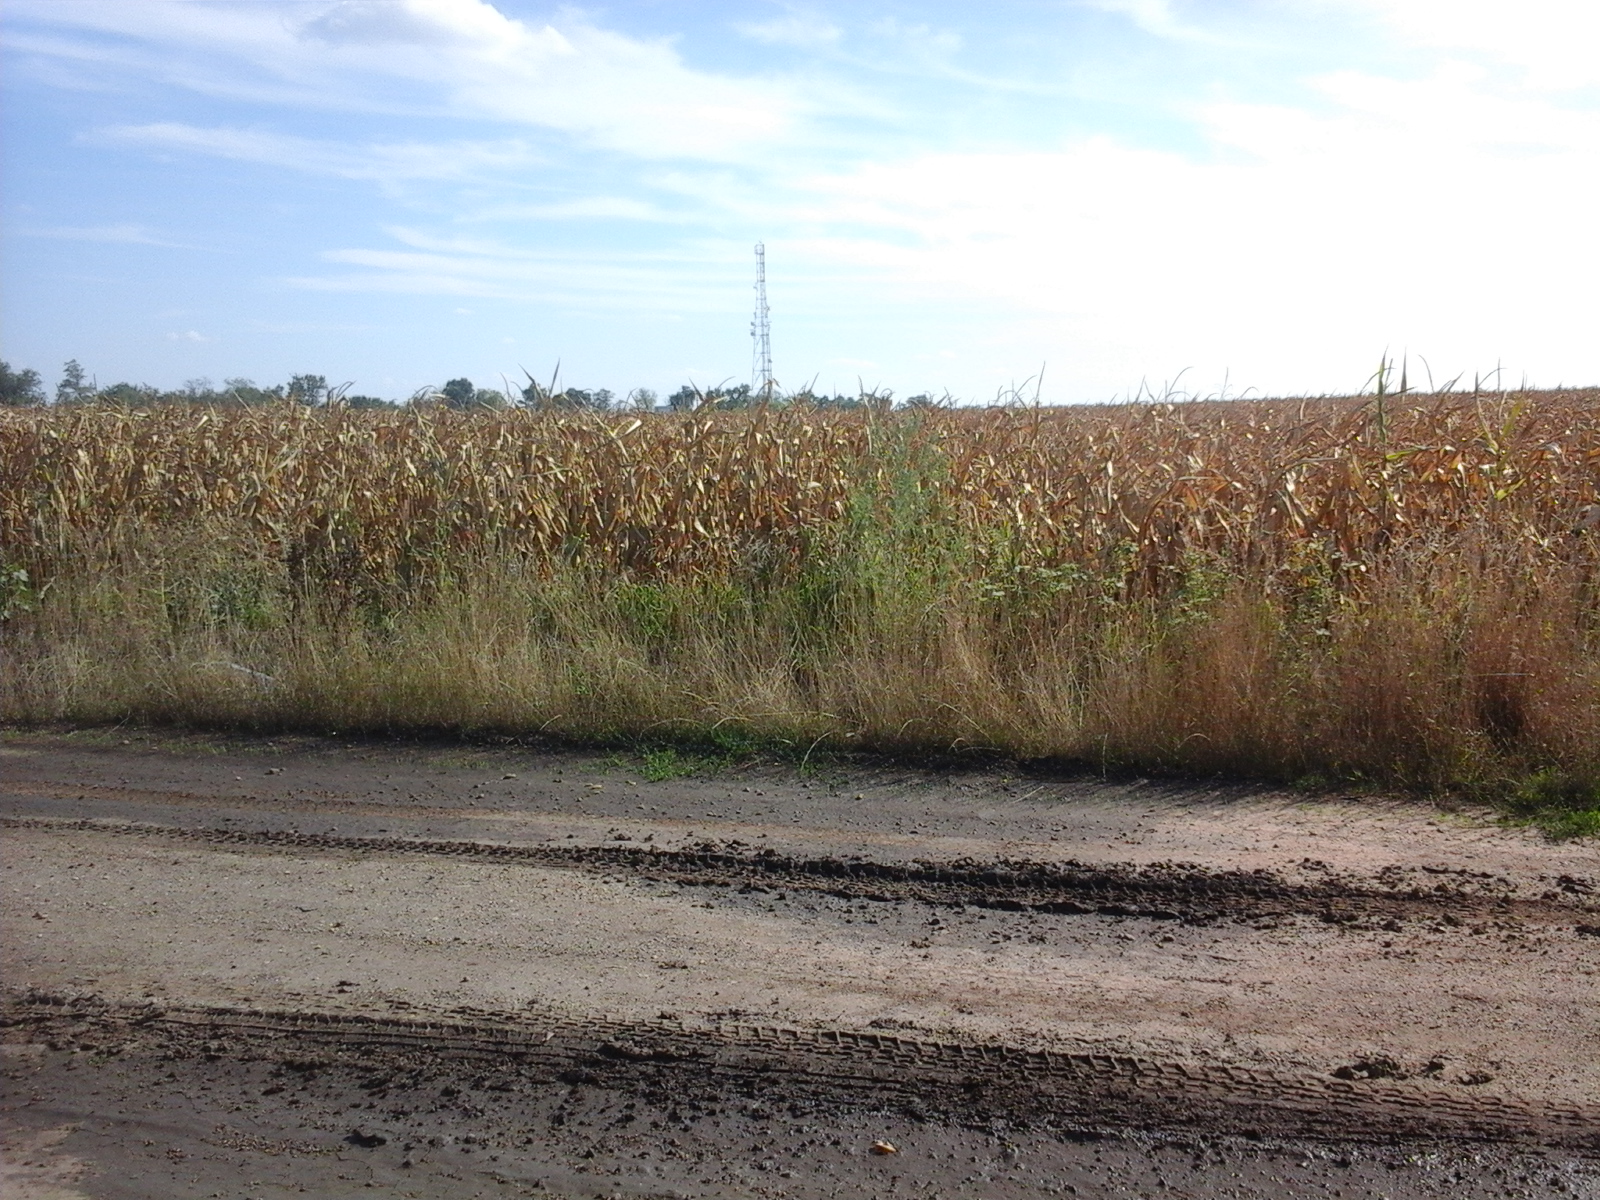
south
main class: Cropland
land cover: Maize
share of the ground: > 75 %
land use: Agriculture (excluding fallow land and kitchen gardens)
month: August
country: RO
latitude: 46.0958
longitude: 21.2994
